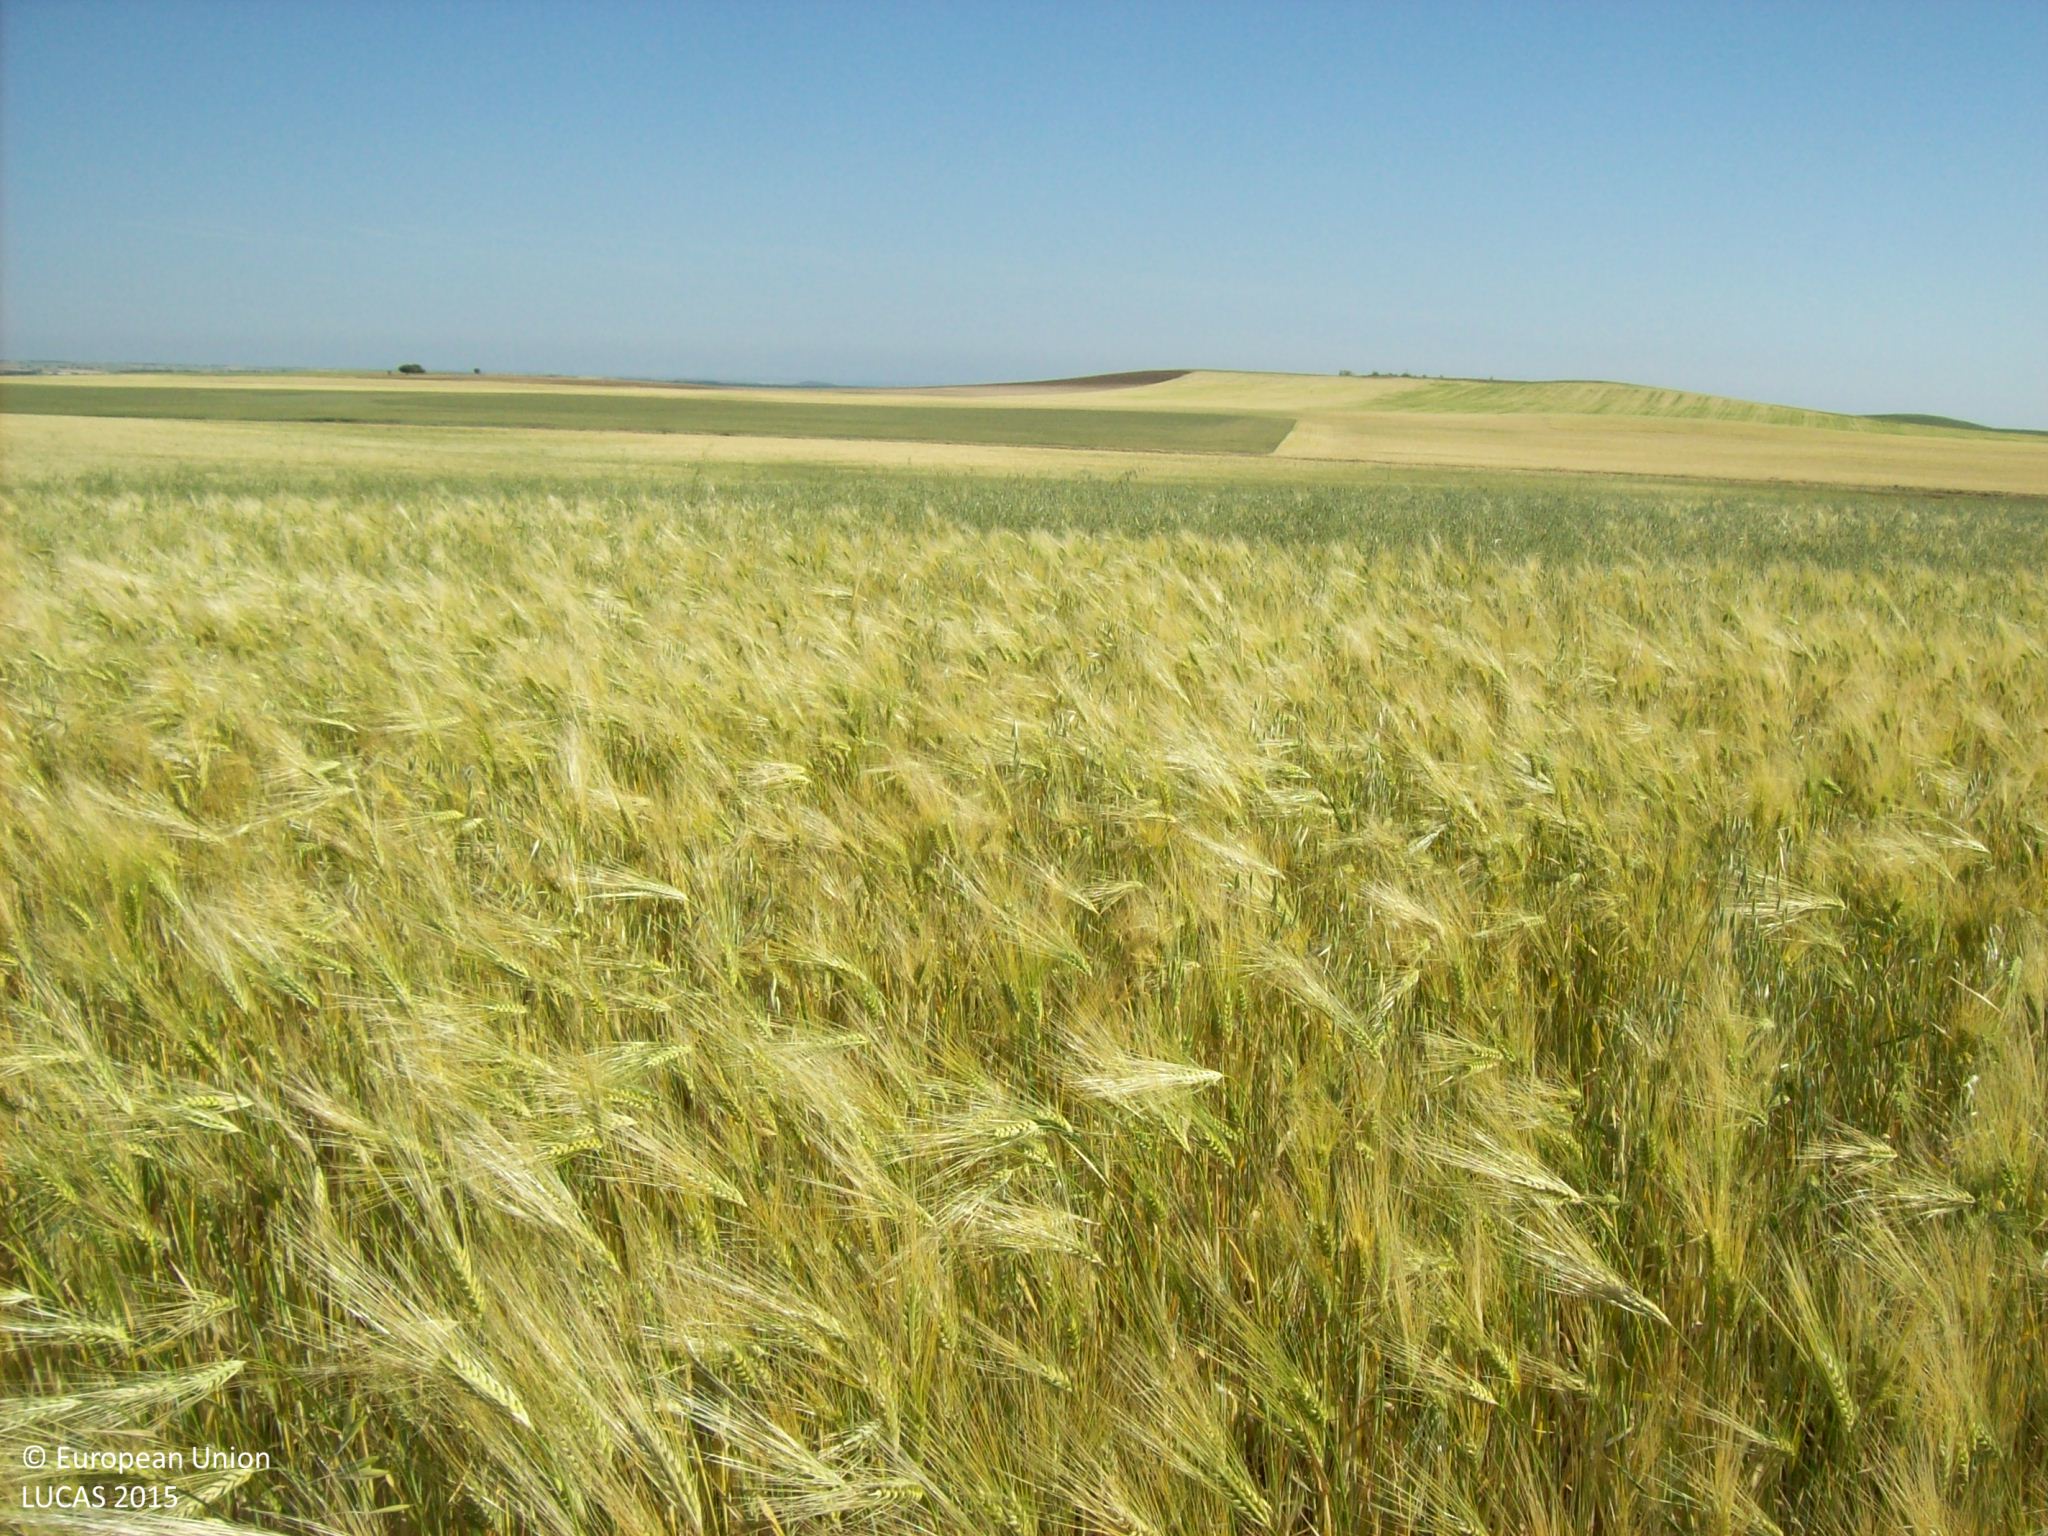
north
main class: Cropland
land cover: Barley
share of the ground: > 75 %
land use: Agriculture (excluding fallow land and kitchen gardens)
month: May
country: ES
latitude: 40.9994
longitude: -4.5013
